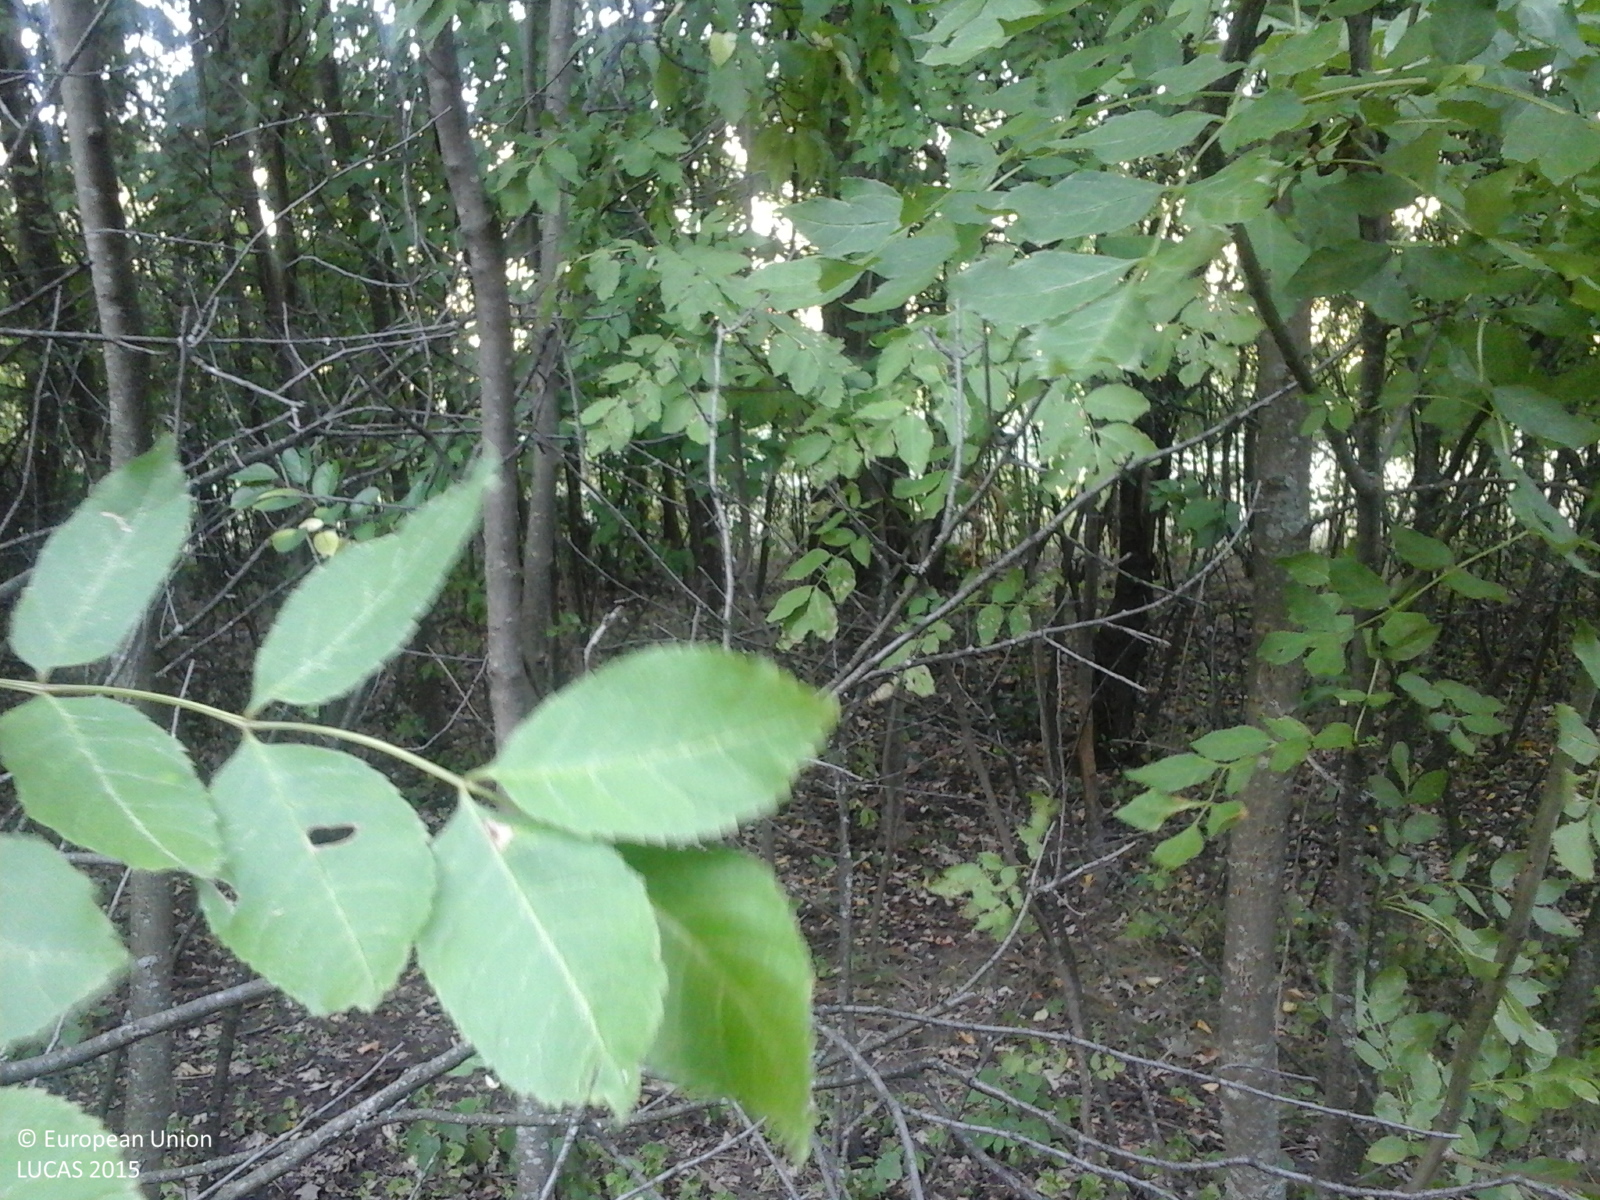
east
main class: Woodland
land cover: Broadleaved woodland
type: mesophytic deciduous forest
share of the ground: > 75 %
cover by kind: broadleaved forest trees 95 %, shrubs 5 %
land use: Forestry
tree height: > 5 m
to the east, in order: Broadleaved woodland; Tracks; Grassland without tree/shrub cover; Lucerne; Sunflower; Grassland without tree/shrub cover; Common wheat; Grassland without tree/shrub cover; Single bushes/trees; Grassland without tree/shrub cover; Sunflower
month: July
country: RO
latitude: 46.3826
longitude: 27.6278
